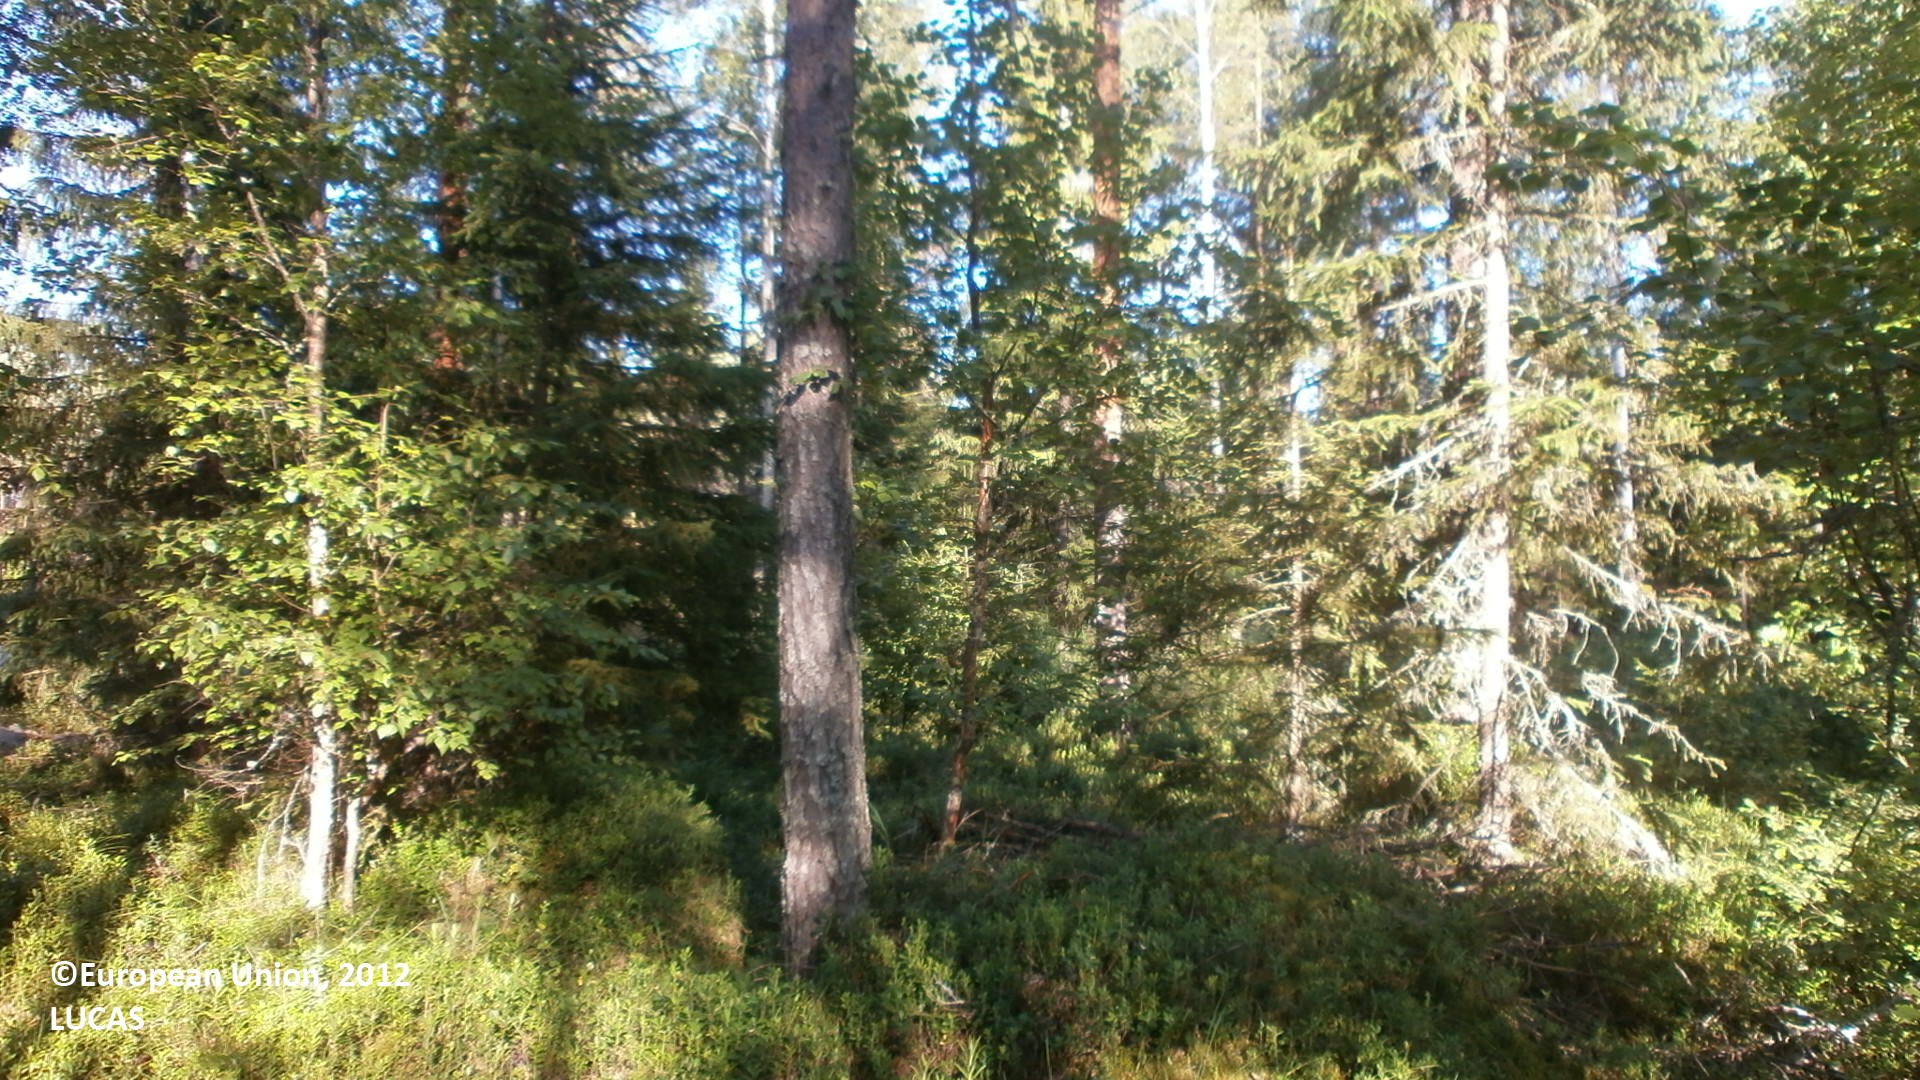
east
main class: Woodland
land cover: Pine dominated coniferous woodland
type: boreal forest
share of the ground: 50 - 75 %
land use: Forestry
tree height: > 5 m
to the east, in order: Pine dominated coniferous woodland; Ditches and canals; Pine dominated mixed woodland; Grassland with sparse tree/shrub cover; Ditches and canals; Pine dominated coniferous woodland; Ditches and canals; Broadleaved woodland; Pine dominated coniferous woodland; Ditches and canals; Pine dominated coniferous woodland; Pine dominated mixed woodland; Pine dominated coniferous woodland
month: July
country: FI
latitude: 64.0344
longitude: 23.9642
